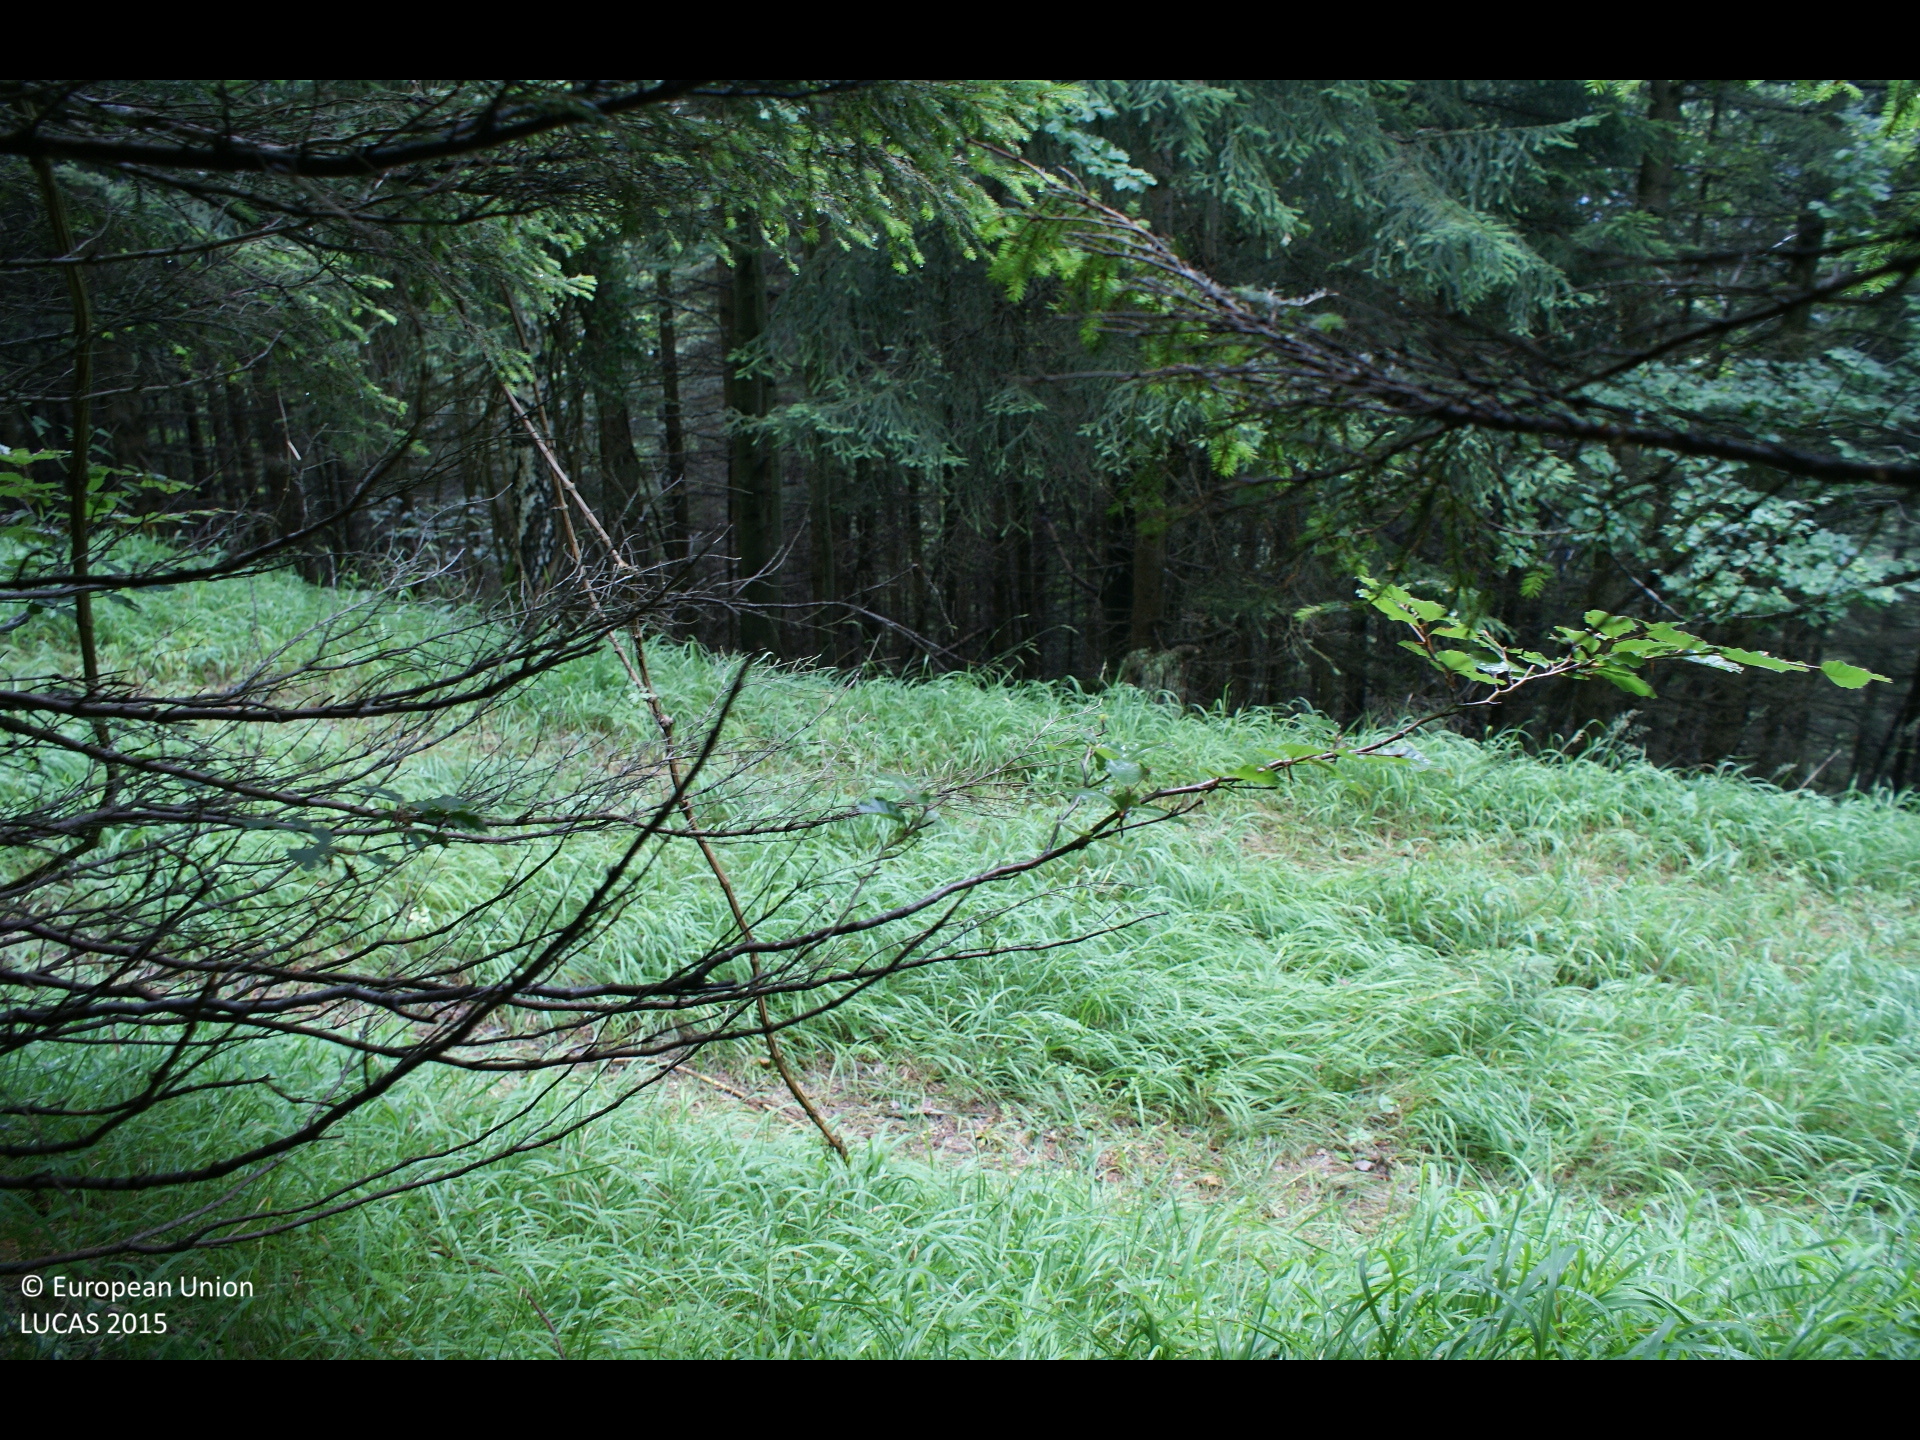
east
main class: Woodland
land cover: Spruce dominated coniferous woodland
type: alpine coniferous forest
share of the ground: > 75 %
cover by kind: coniferous forest trees 80 %, broadleaved forest trees 15 %, herbaceous plants 5 %
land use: Forestry
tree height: > 5 m
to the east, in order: Spruce dominated coniferous woodland; Grass margins; Tracks; Grass margins; Spruce dominated coniferous woodland; Spruce dominated mixed woodland; Tracks; Other mixed woodland; Tracks; Spruce dominated coniferous woodland; Tracks; Spruce dominated coniferous woodland; Shrubland with sparse tree cover; Spruce dominated coniferous woodland
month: July
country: AT
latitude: 47.8404
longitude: 14.9844
